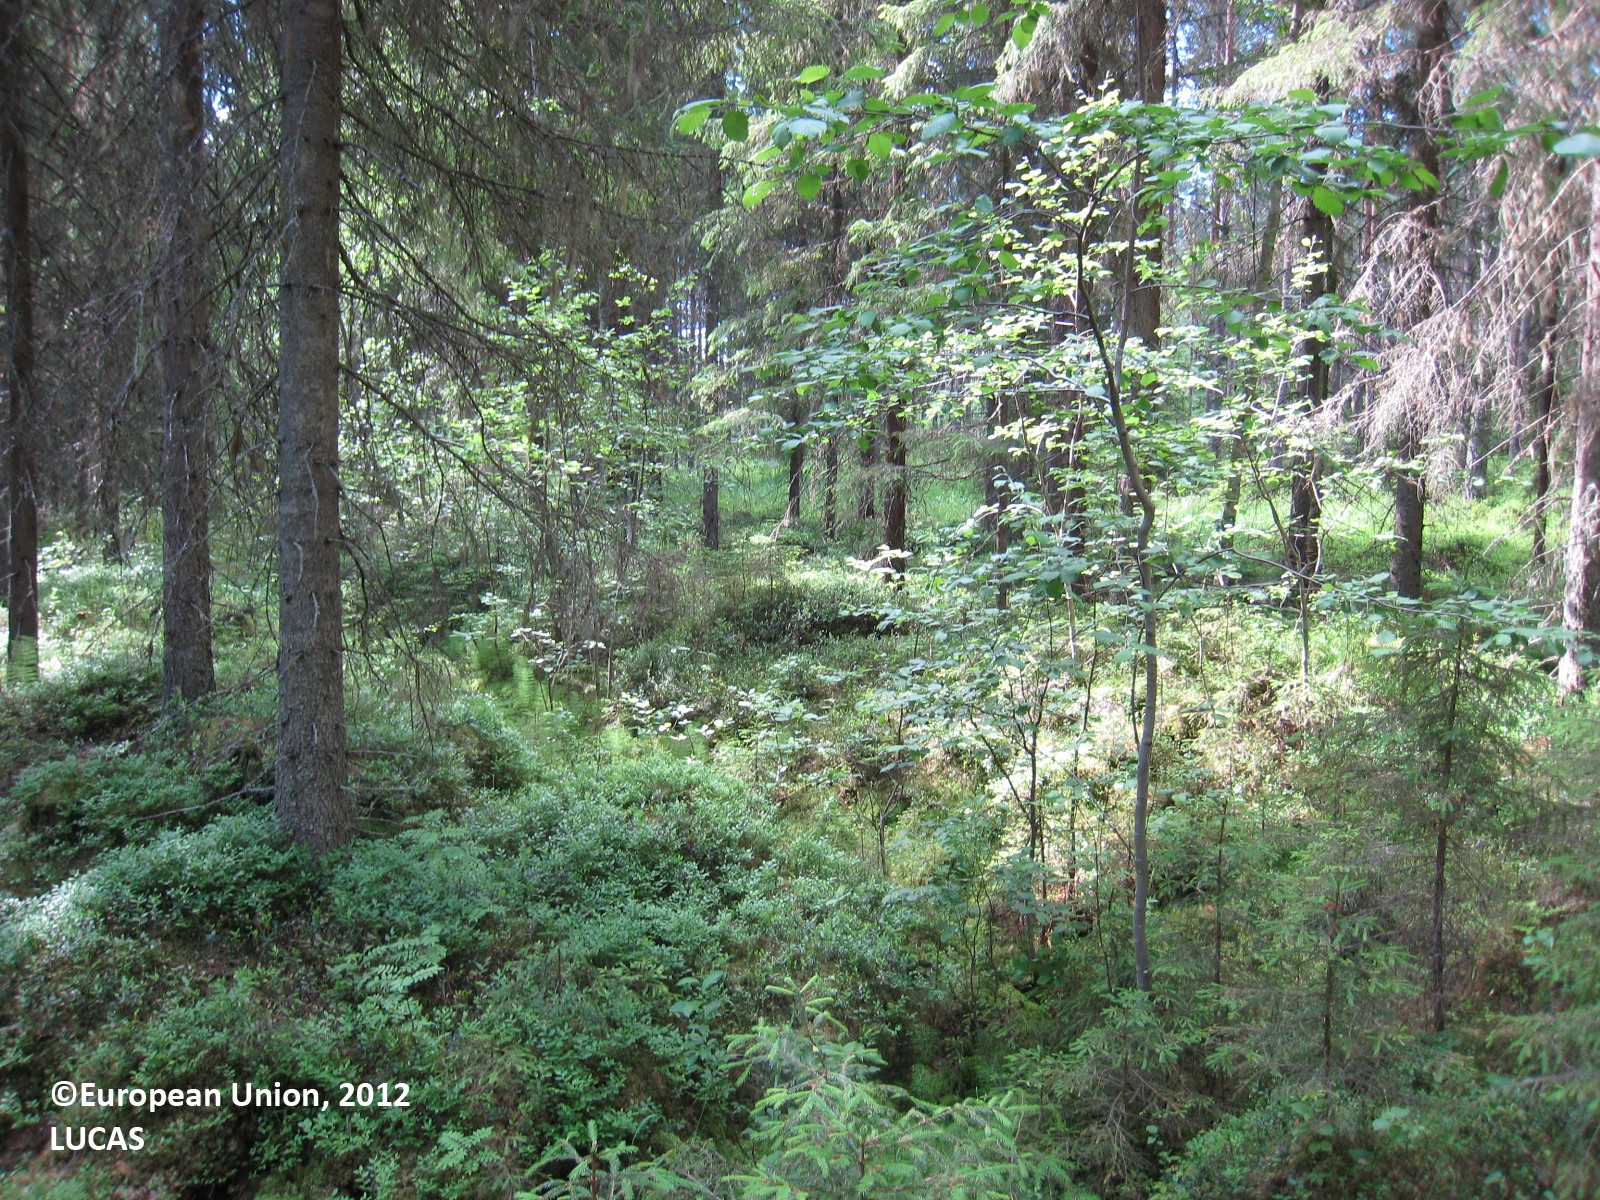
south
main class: Woodland
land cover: Spruce dominated coniferous woodland
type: boreal forest
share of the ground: 50 - 75 %
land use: Forestry
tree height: > 5 m
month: July
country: FI
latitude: 63.1970
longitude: 25.7545
